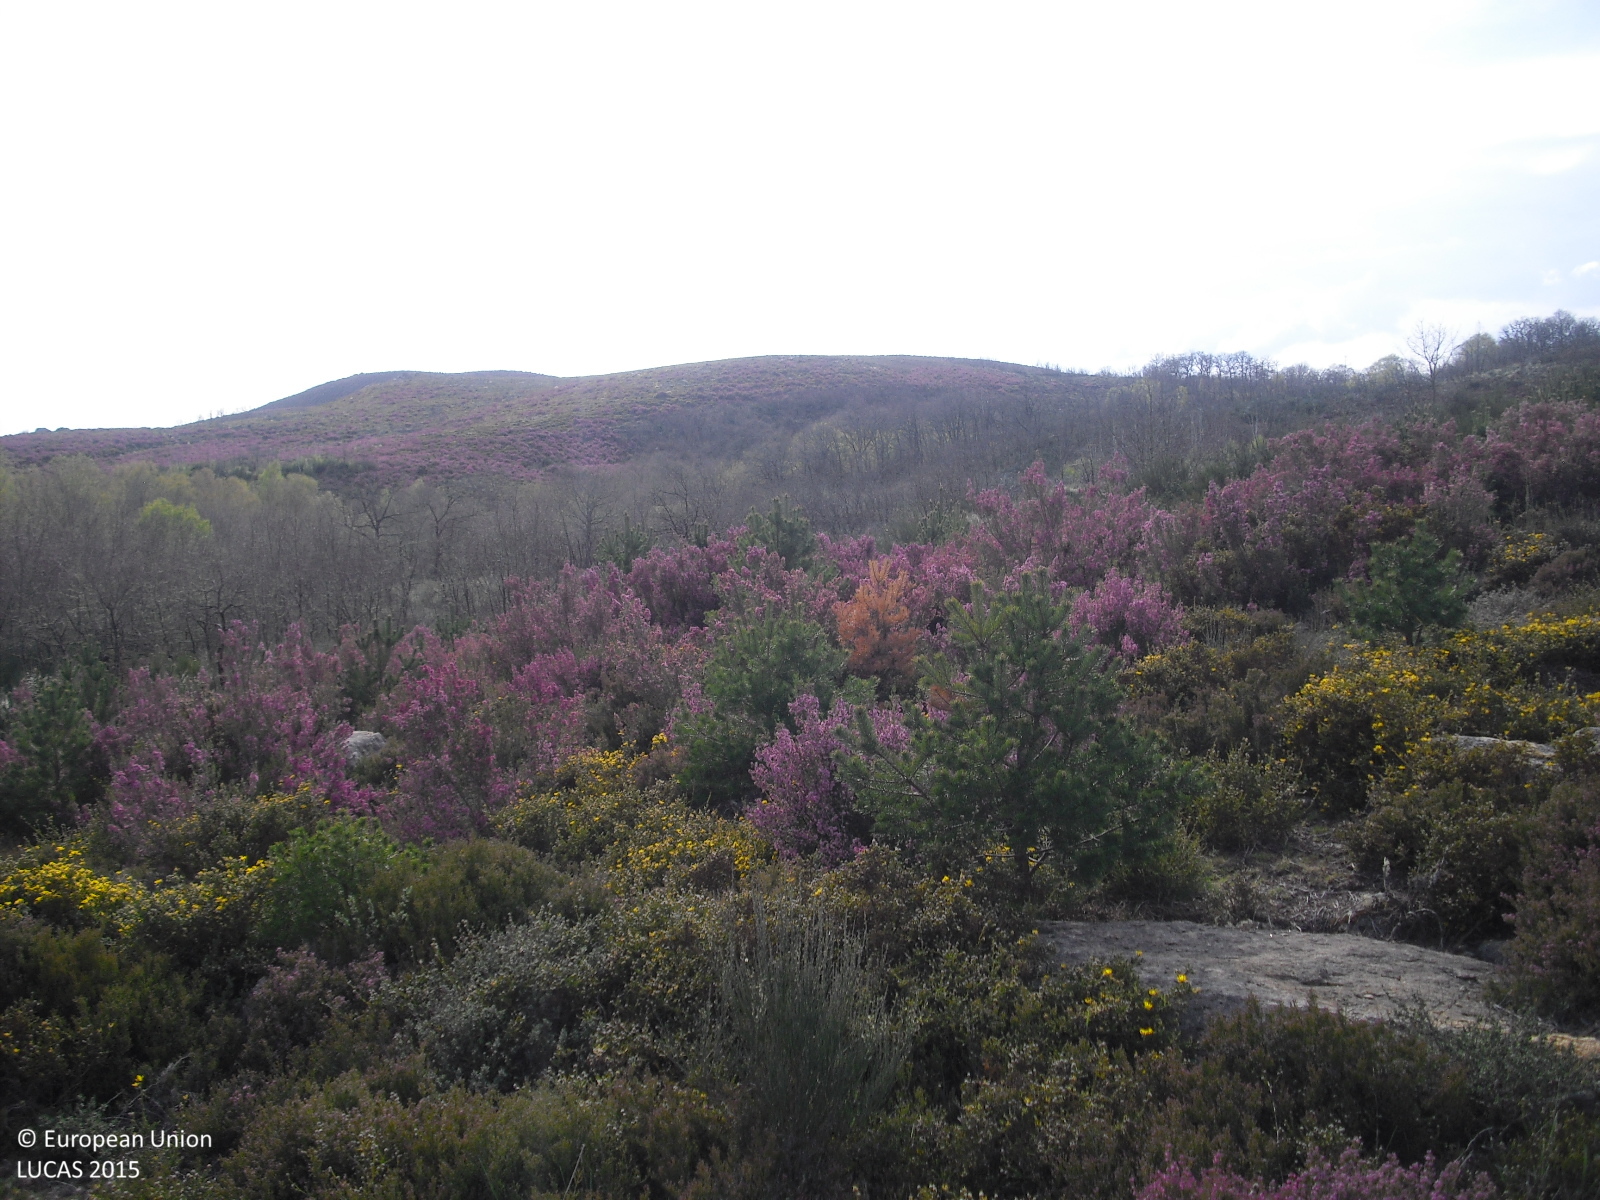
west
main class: Woodland
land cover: Pine dominated coniferous woodland
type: exotic forest
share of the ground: 10 - 25 %
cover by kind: shrubs 70 %, coniferous forest trees 15 %, consolidated bare surface 15 %
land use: Forestry
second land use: Other primary production
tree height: < 5 m
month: April
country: ES
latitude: 41.9580
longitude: -7.7435
